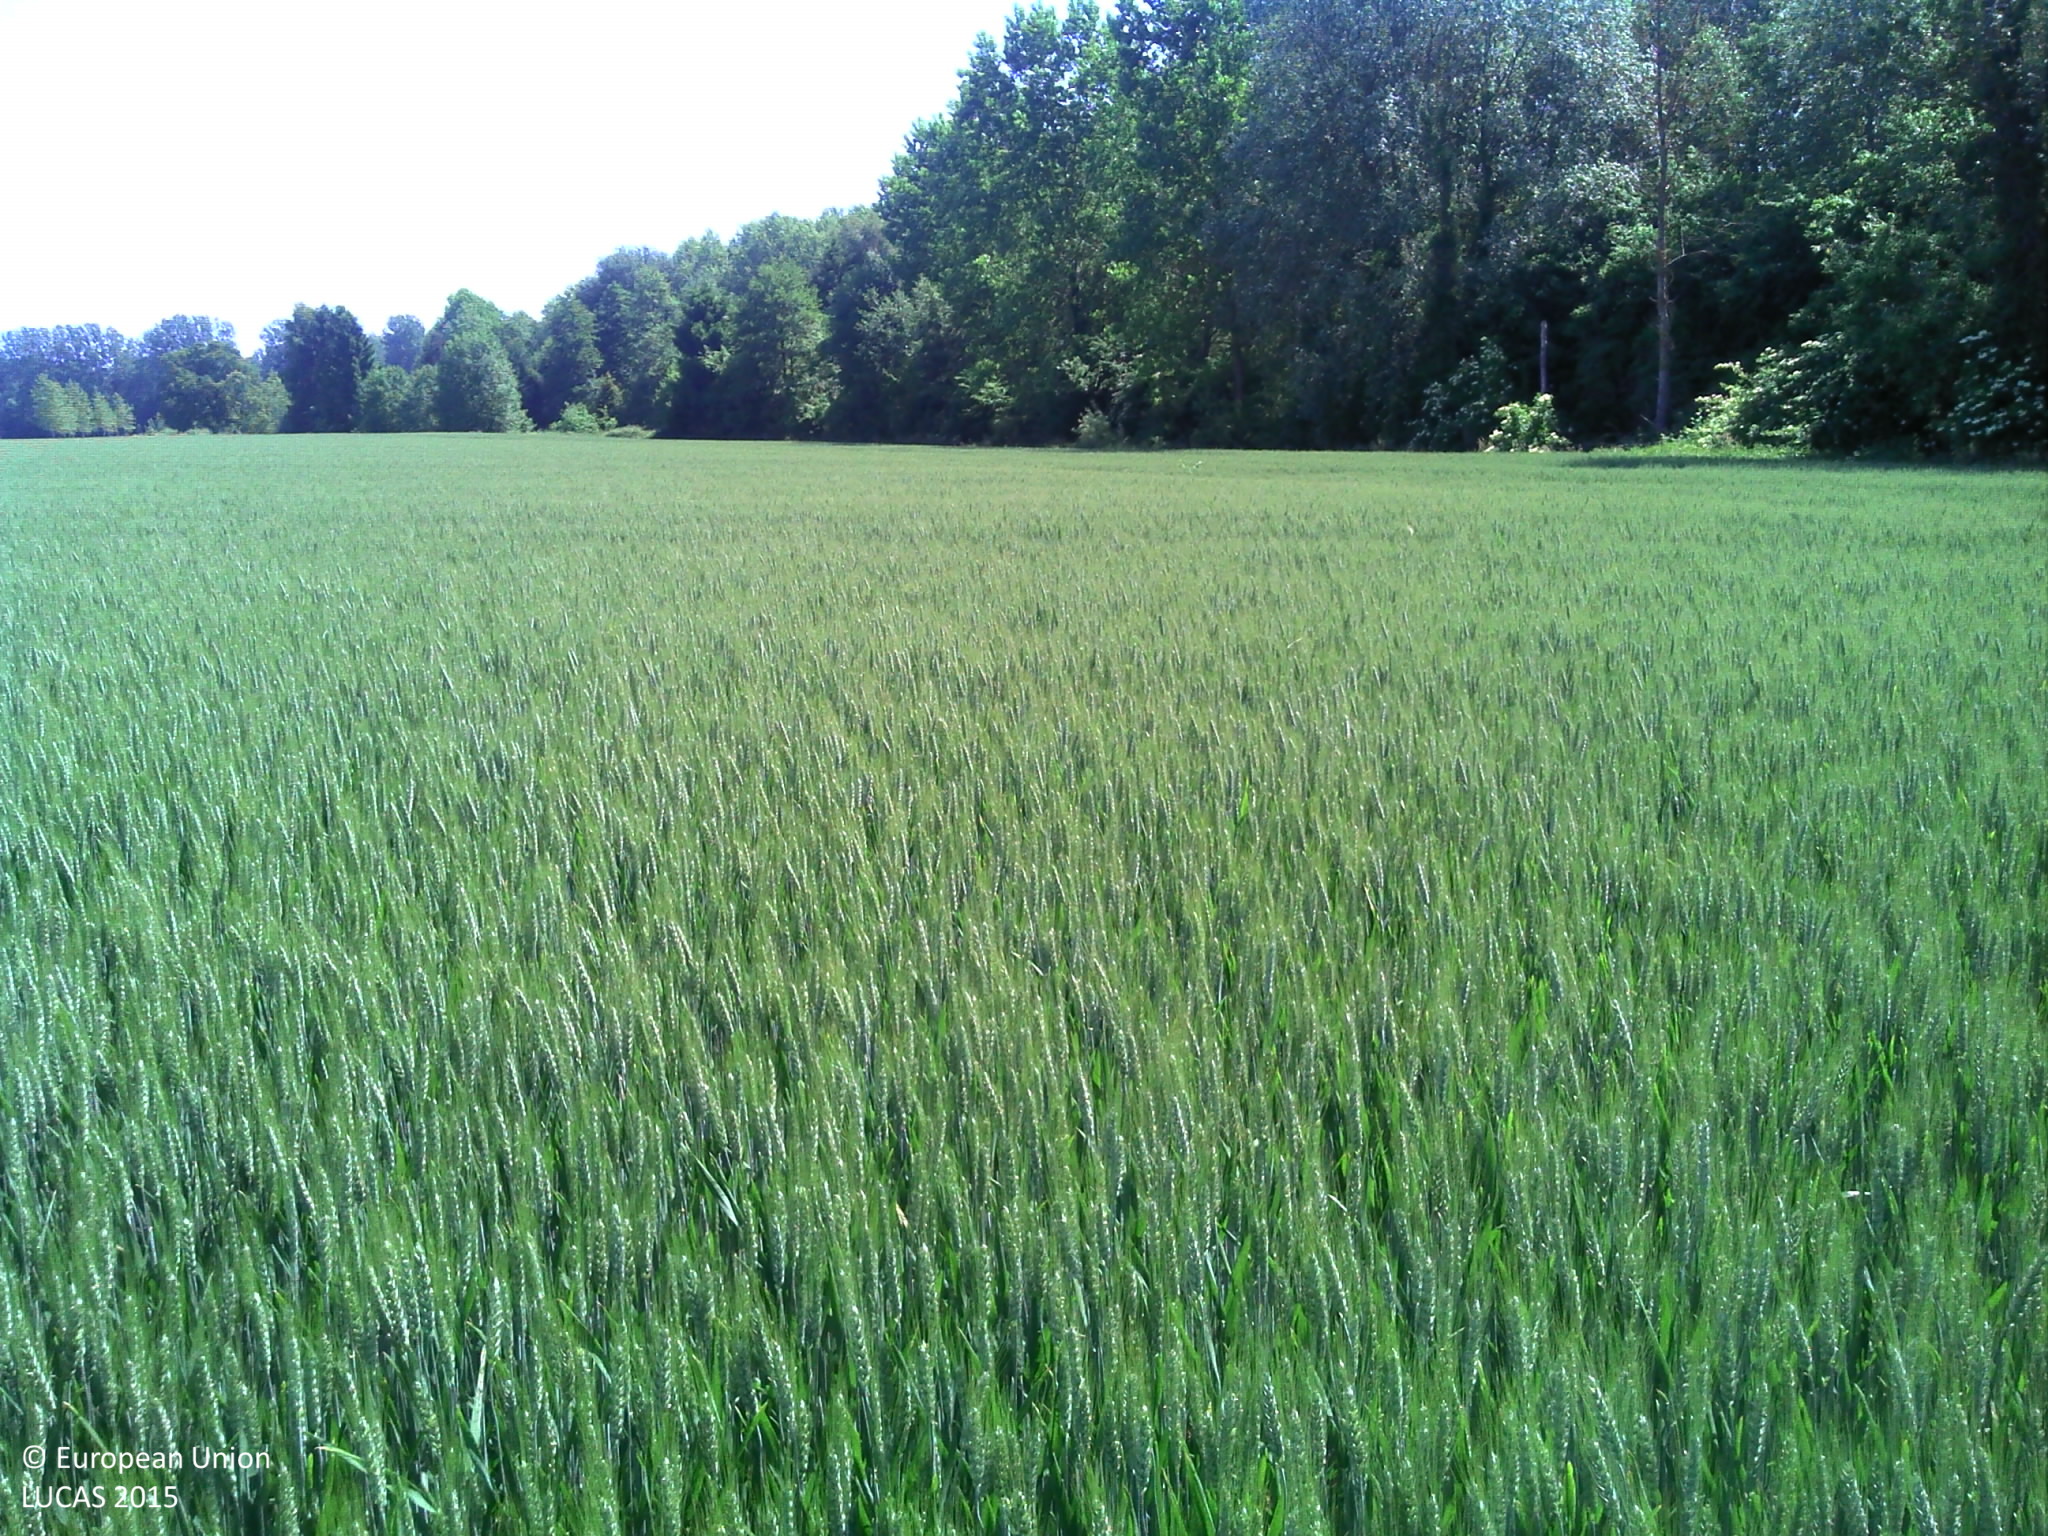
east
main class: Cropland
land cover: Common wheat
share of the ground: > 75 %
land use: Agriculture (excluding fallow land and kitchen gardens)
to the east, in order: Common wheat; Electric lines; Common wheat; Spontaneously vegetated surfaces; Broadleaved woodland; Spontaneously vegetated surfaces; Sugar beet
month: June
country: FR
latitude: 49.5695
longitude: 3.2577
